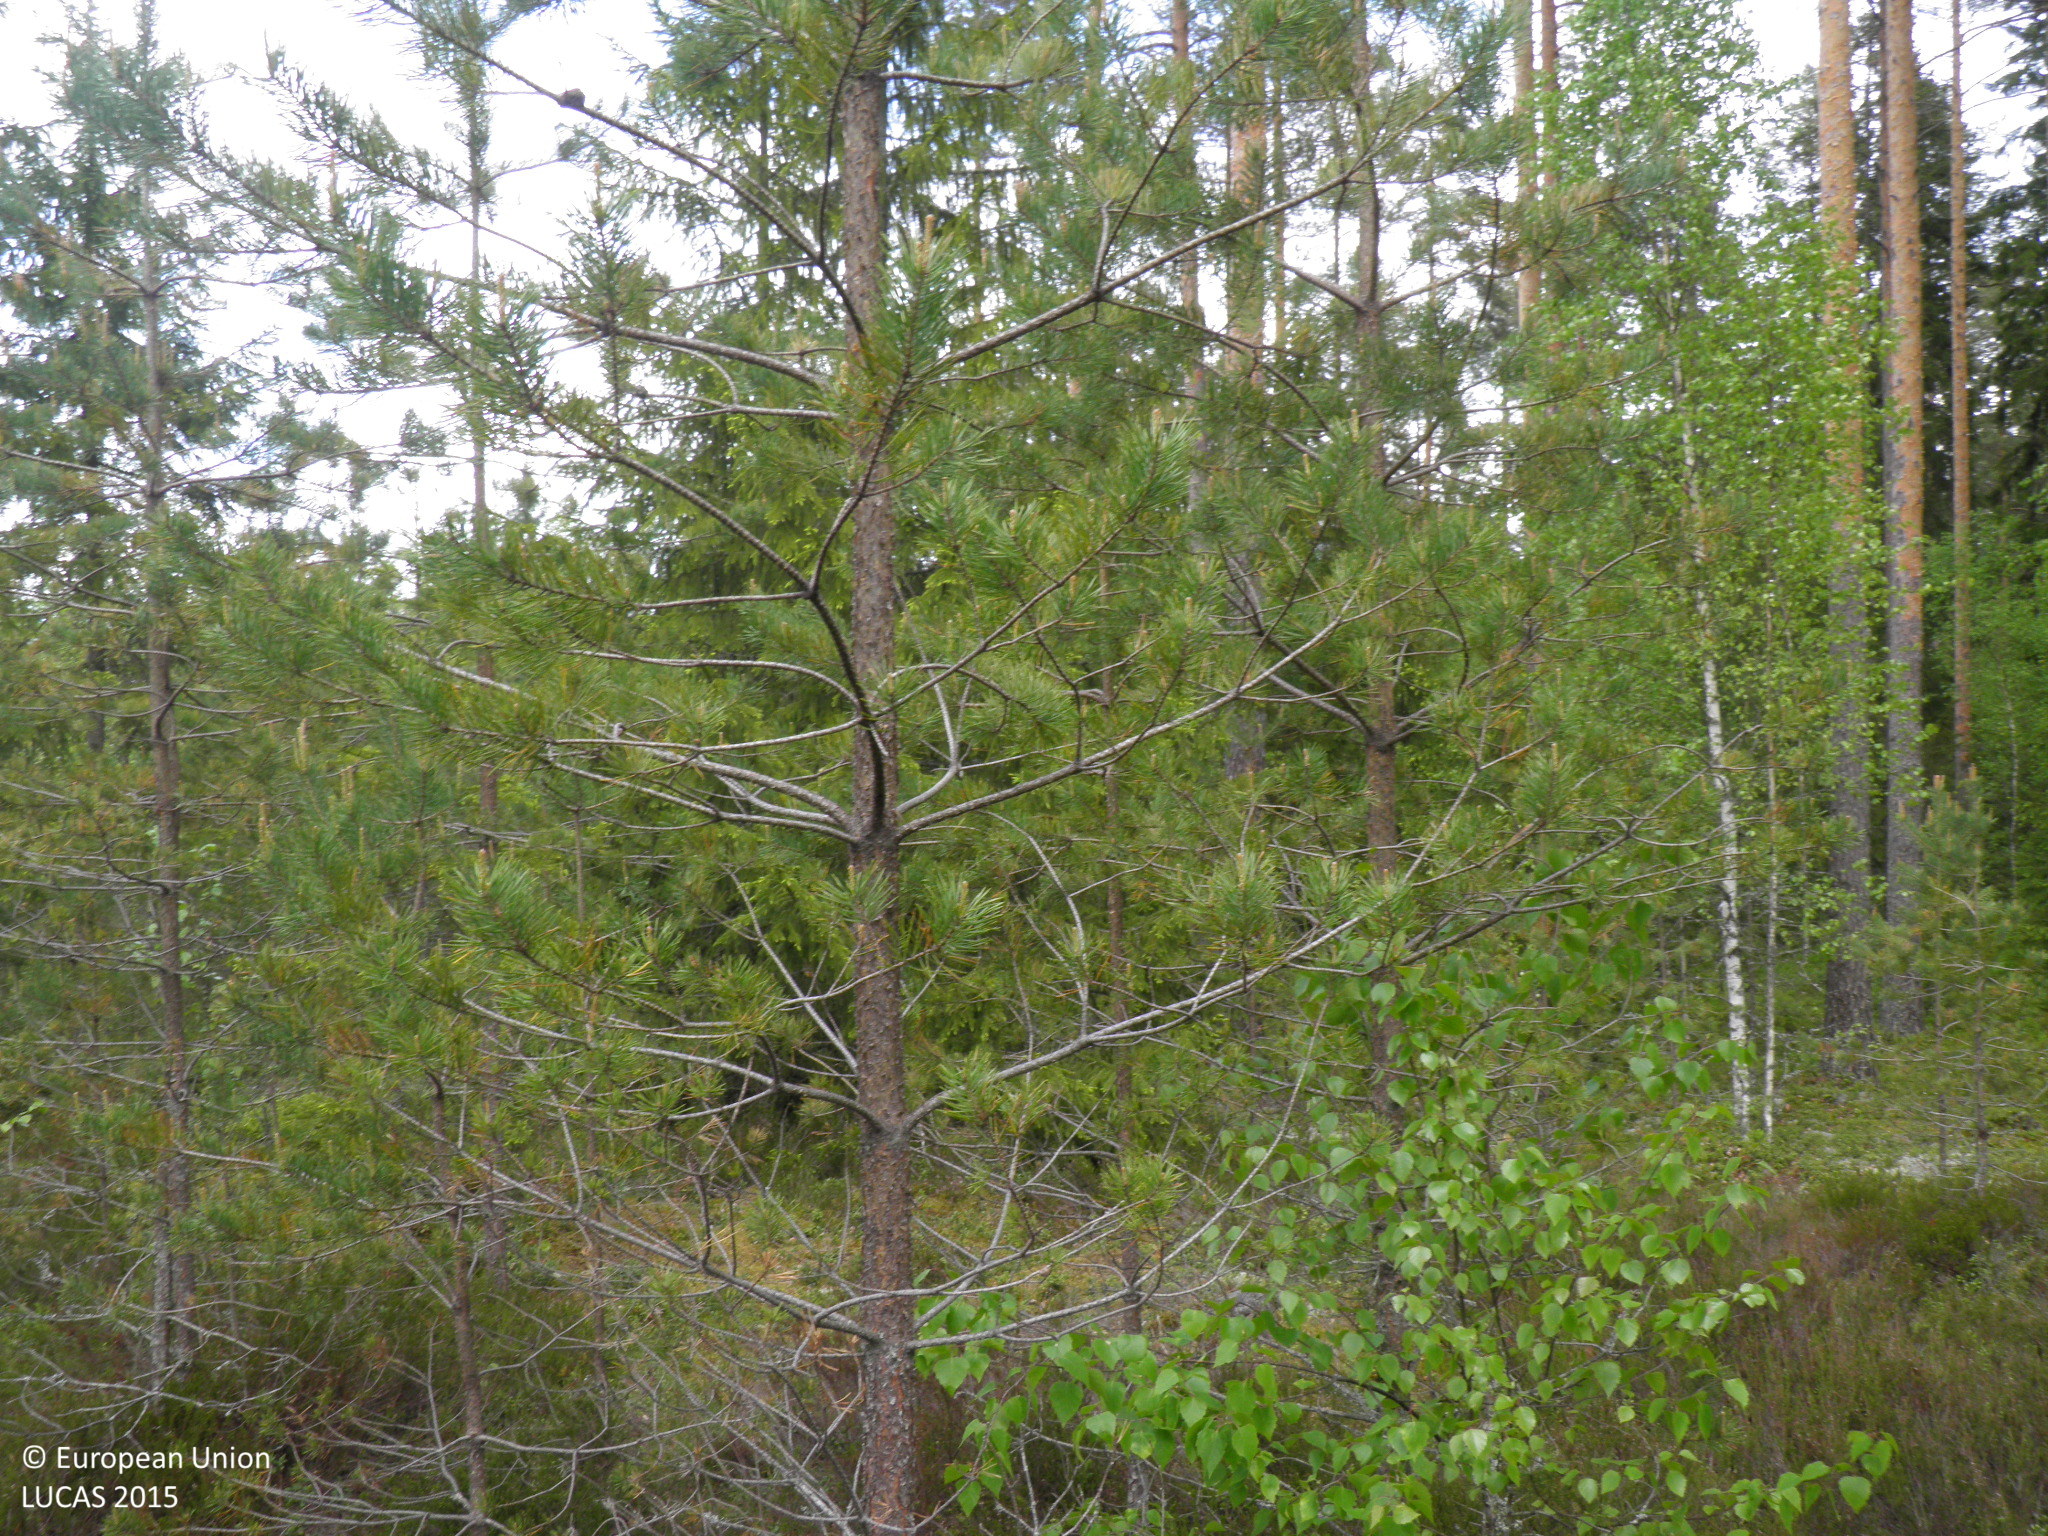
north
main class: Woodland
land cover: Pine dominated coniferous woodland
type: boreal forest
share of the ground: > 75 %
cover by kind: coniferous forest trees 85 %, shrubs 10 %, broadleaved forest trees 5 %
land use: Forestry
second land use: Sport
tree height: > 5 m
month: June
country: FI
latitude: 60.5850
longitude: 22.7597
